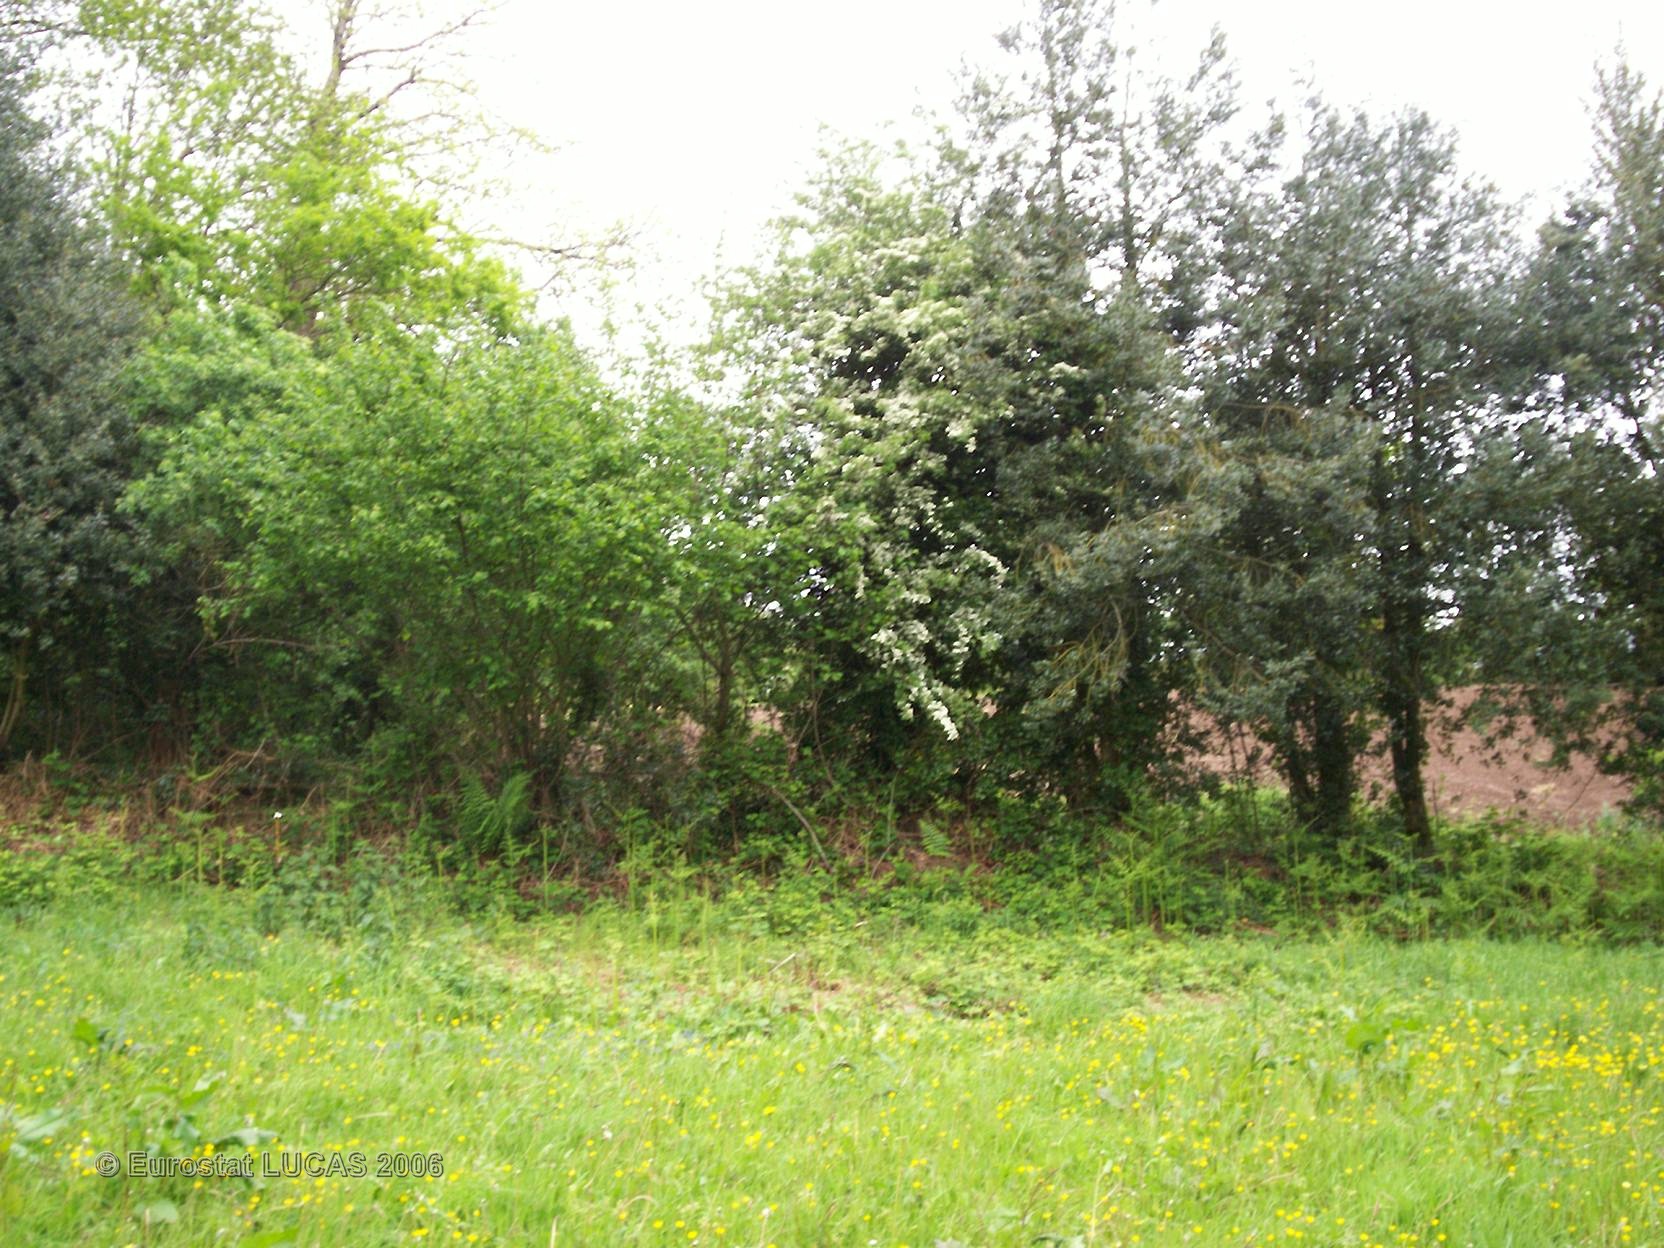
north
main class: Grassland
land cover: Grassland without tree/shrub cover
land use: Agriculture (excluding fallow land and kitchen gardens)
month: May
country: FR
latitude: 48.0686
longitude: -3.8940
